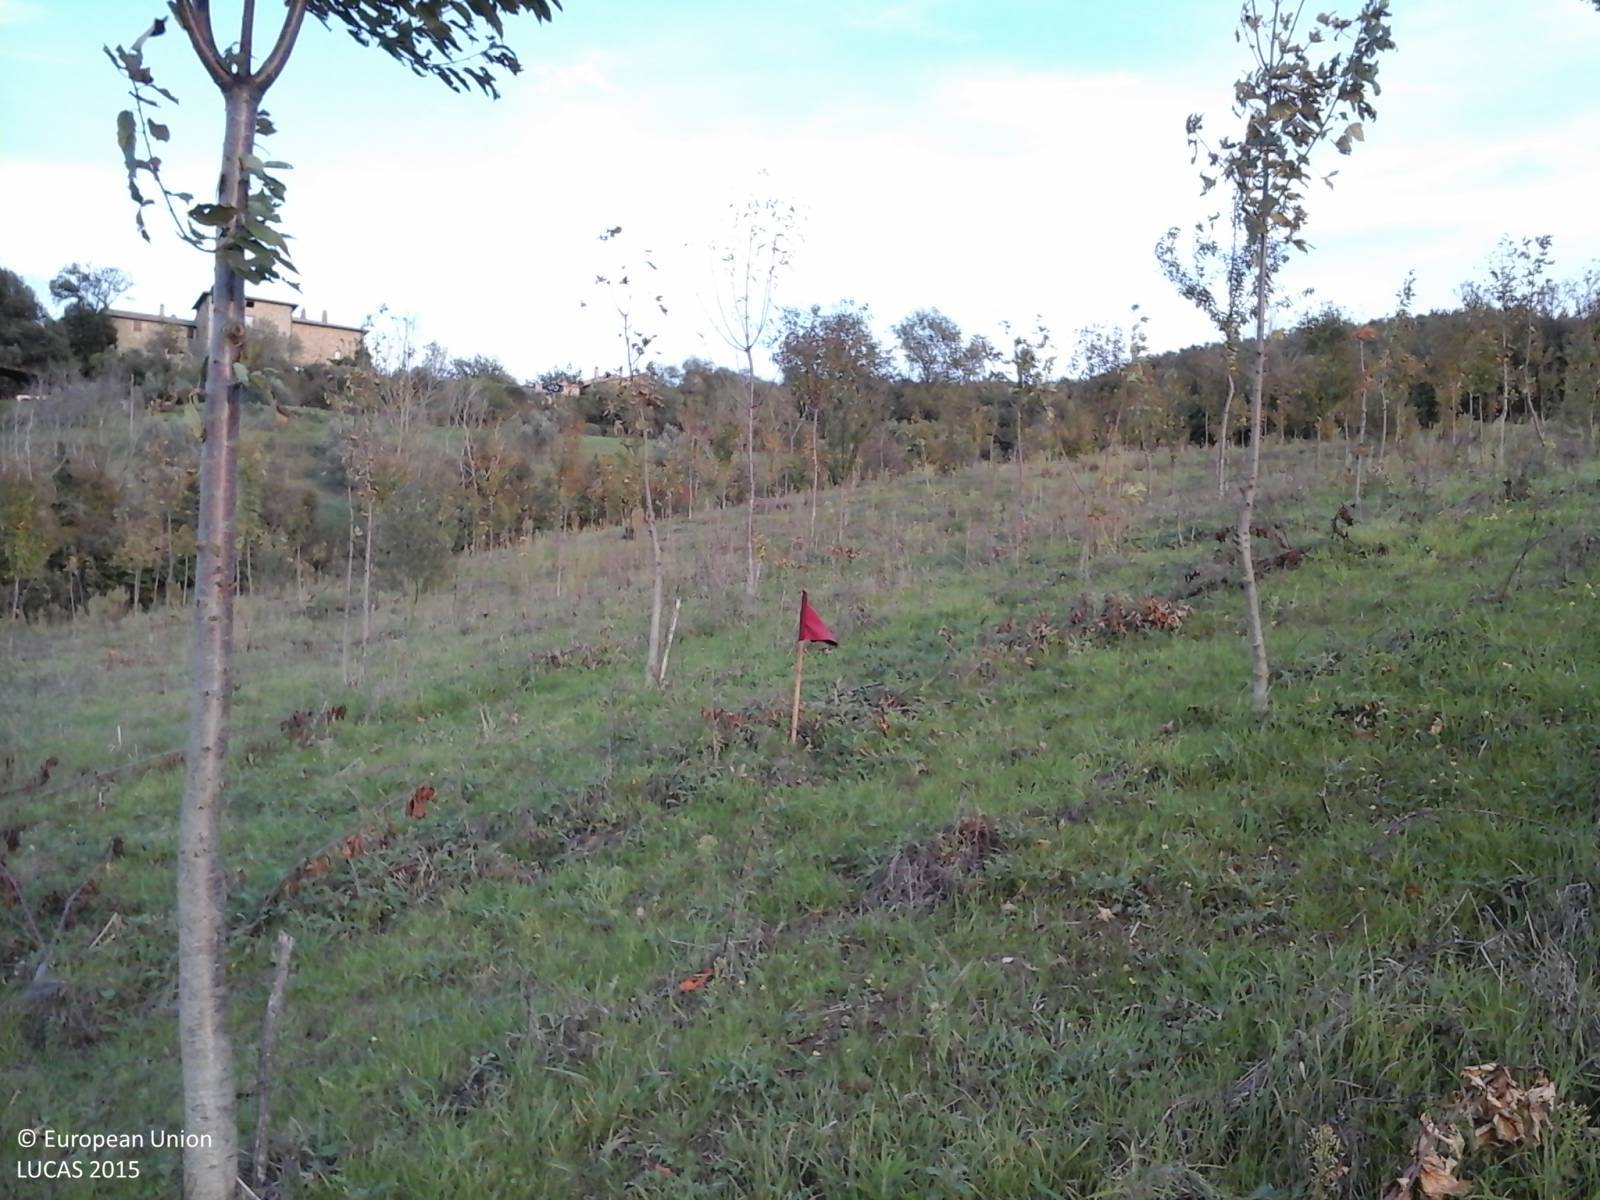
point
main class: Cropland
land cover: Cherry fruit
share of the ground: 50 - 75 %
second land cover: Spontaneously vegetated surfaces
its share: > 75 %
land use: Agriculture (excluding fallow land and kitchen gardens)
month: October
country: IT
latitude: 42.8085
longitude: 12.3041
